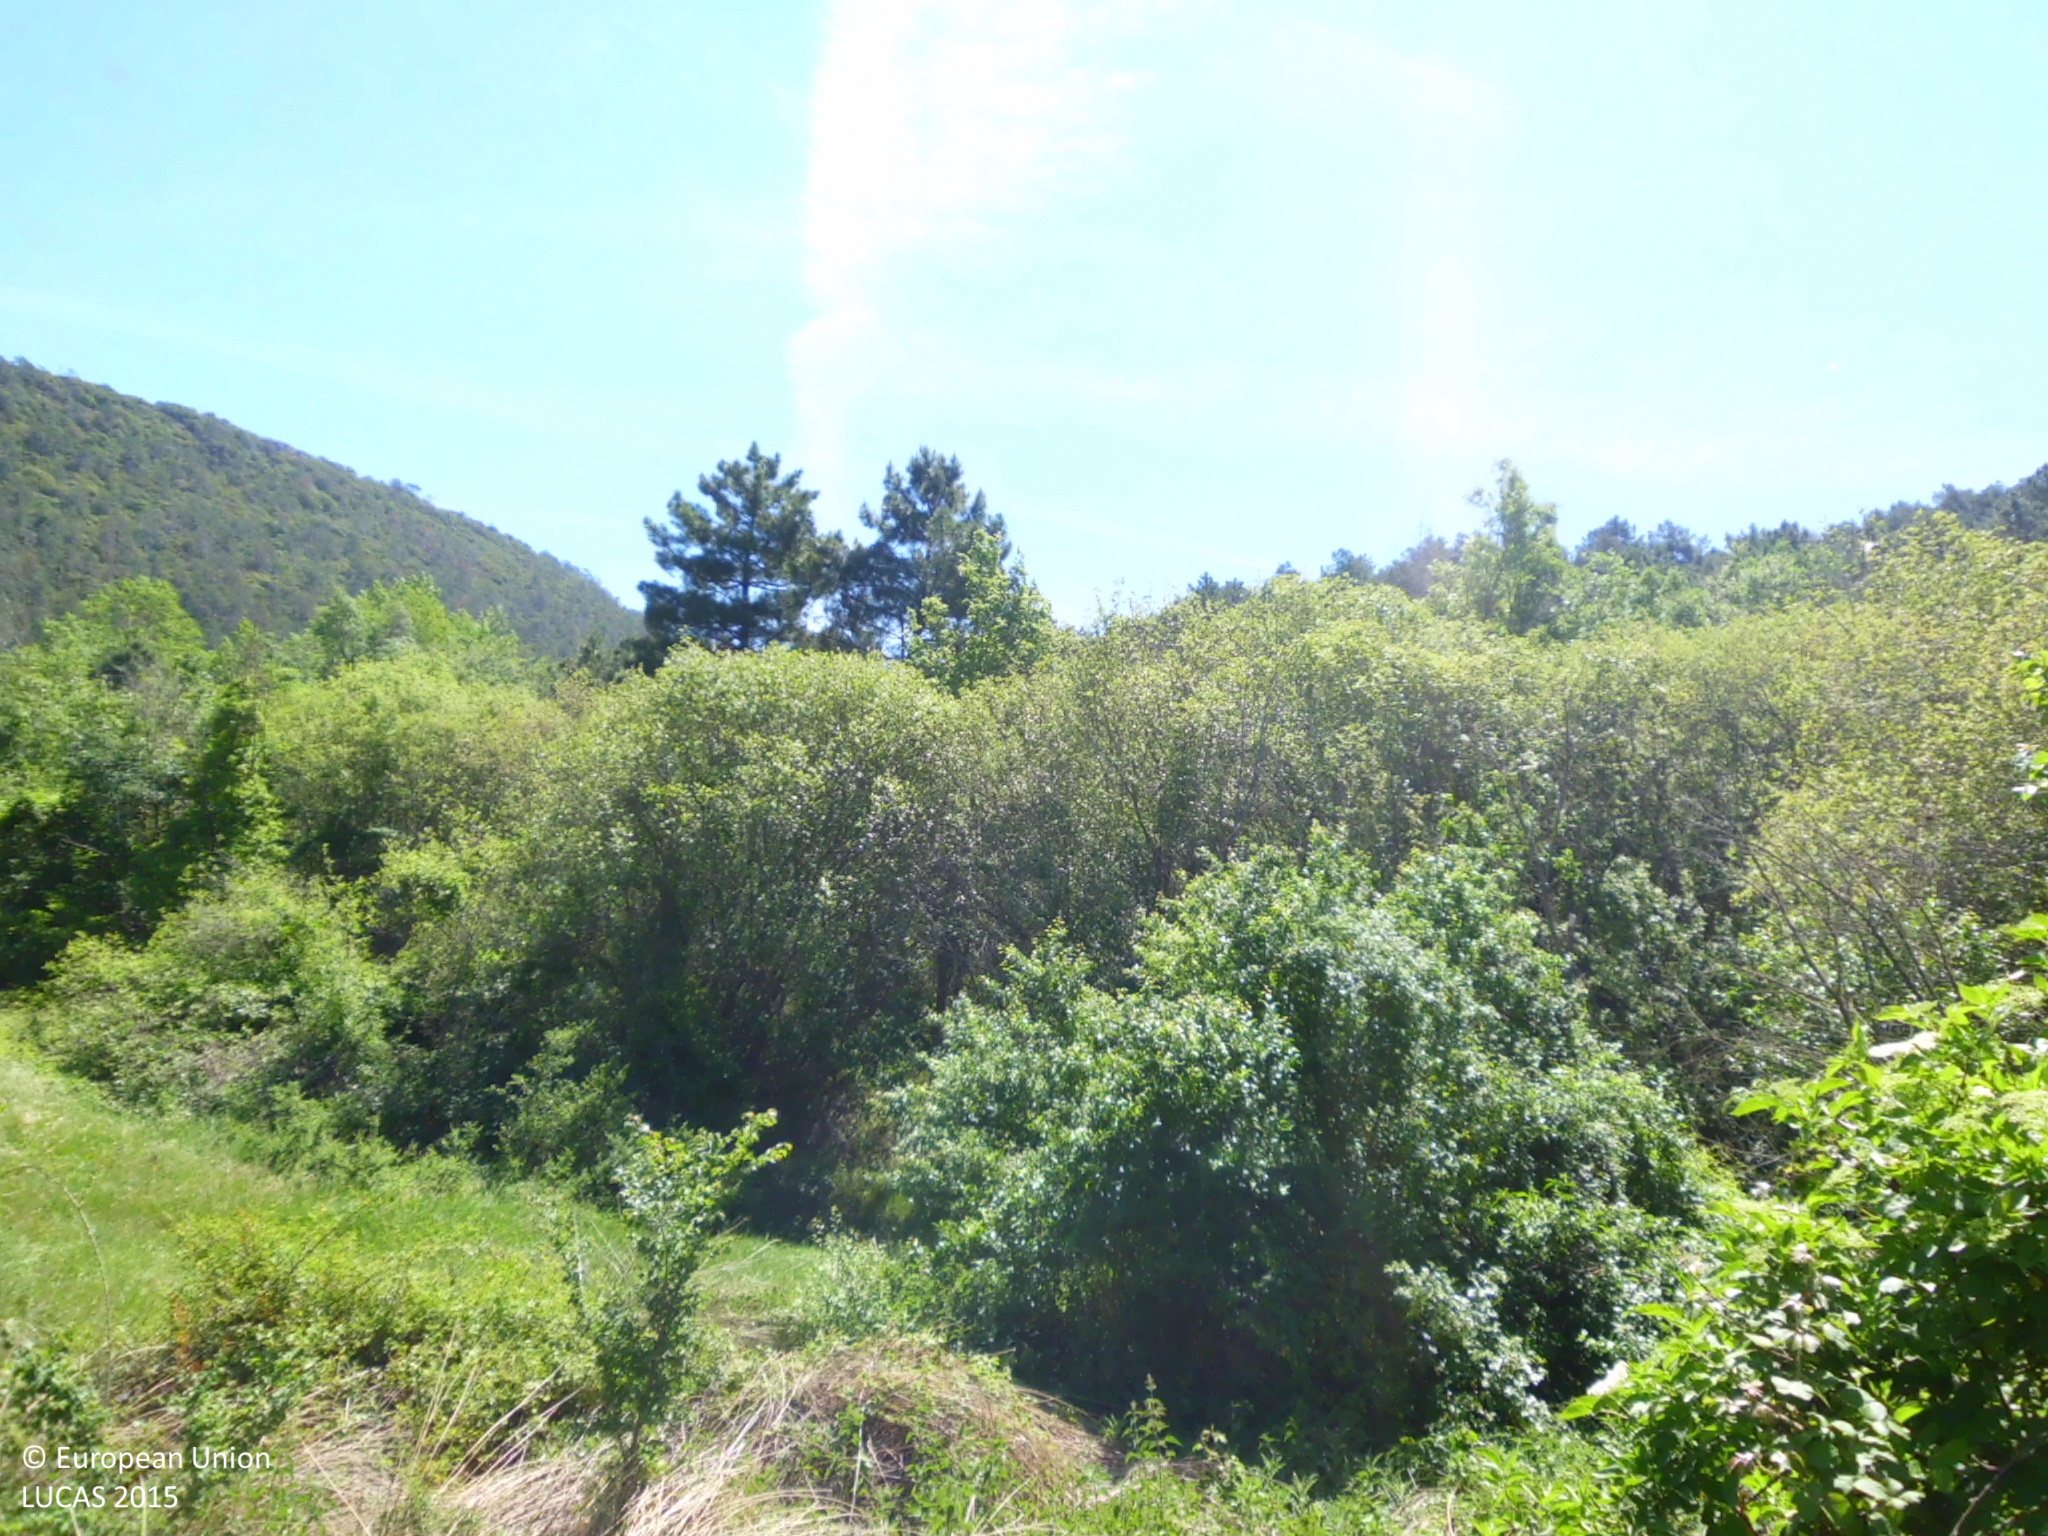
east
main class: Woodland
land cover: Other mixed woodland
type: acidophilous oak and oak-birch forest
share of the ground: > 75 %
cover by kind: broadleaved forest trees 60 %, coniferous forest trees 20 %, shrubs 20 %
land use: Semi-natural and natural areas not in use
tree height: > 5 m
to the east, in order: Other mixed woodland; Pine dominated mixed woodland
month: May
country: ES
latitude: 42.7058
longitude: -3.4288
